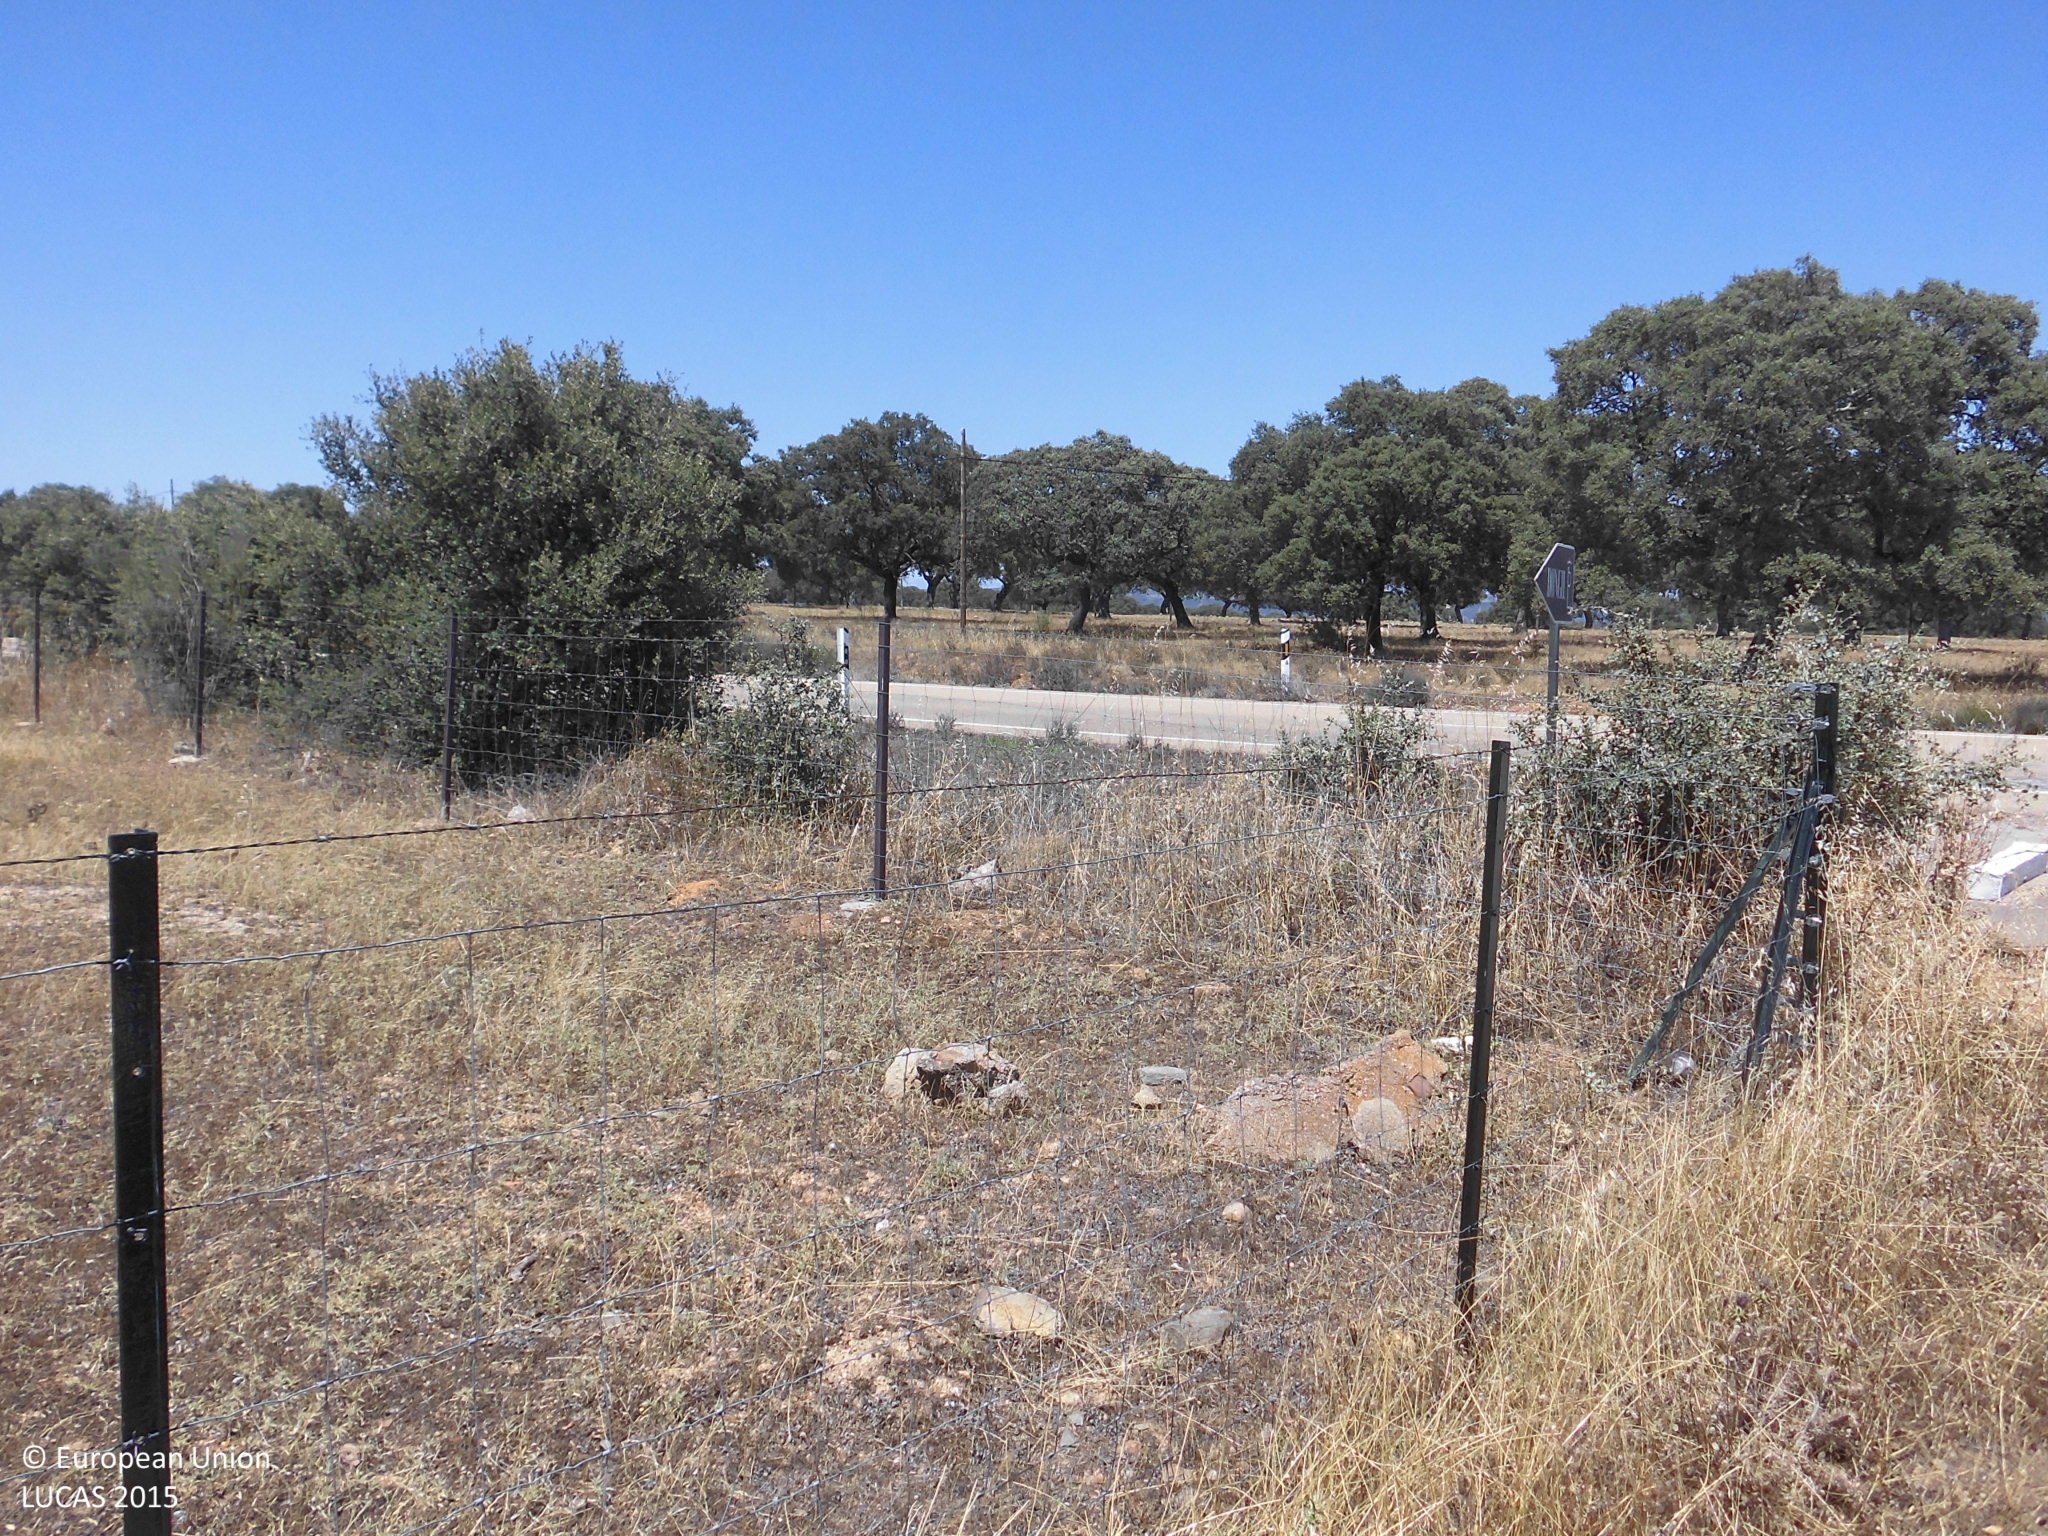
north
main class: Woodland
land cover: Broadleaved woodland
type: broadleaved evergreen forest
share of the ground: 10 - 25 %
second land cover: Grassland without tree/shrub cover
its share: > 75 %
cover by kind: herbaceous plants 80 %, broadleaved forest trees 20 %
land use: Forestry
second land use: Agriculture (excluding fallow land and kitchen gardens)
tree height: > 5 m
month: June
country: ES
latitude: 39.7334
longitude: -6.0154
